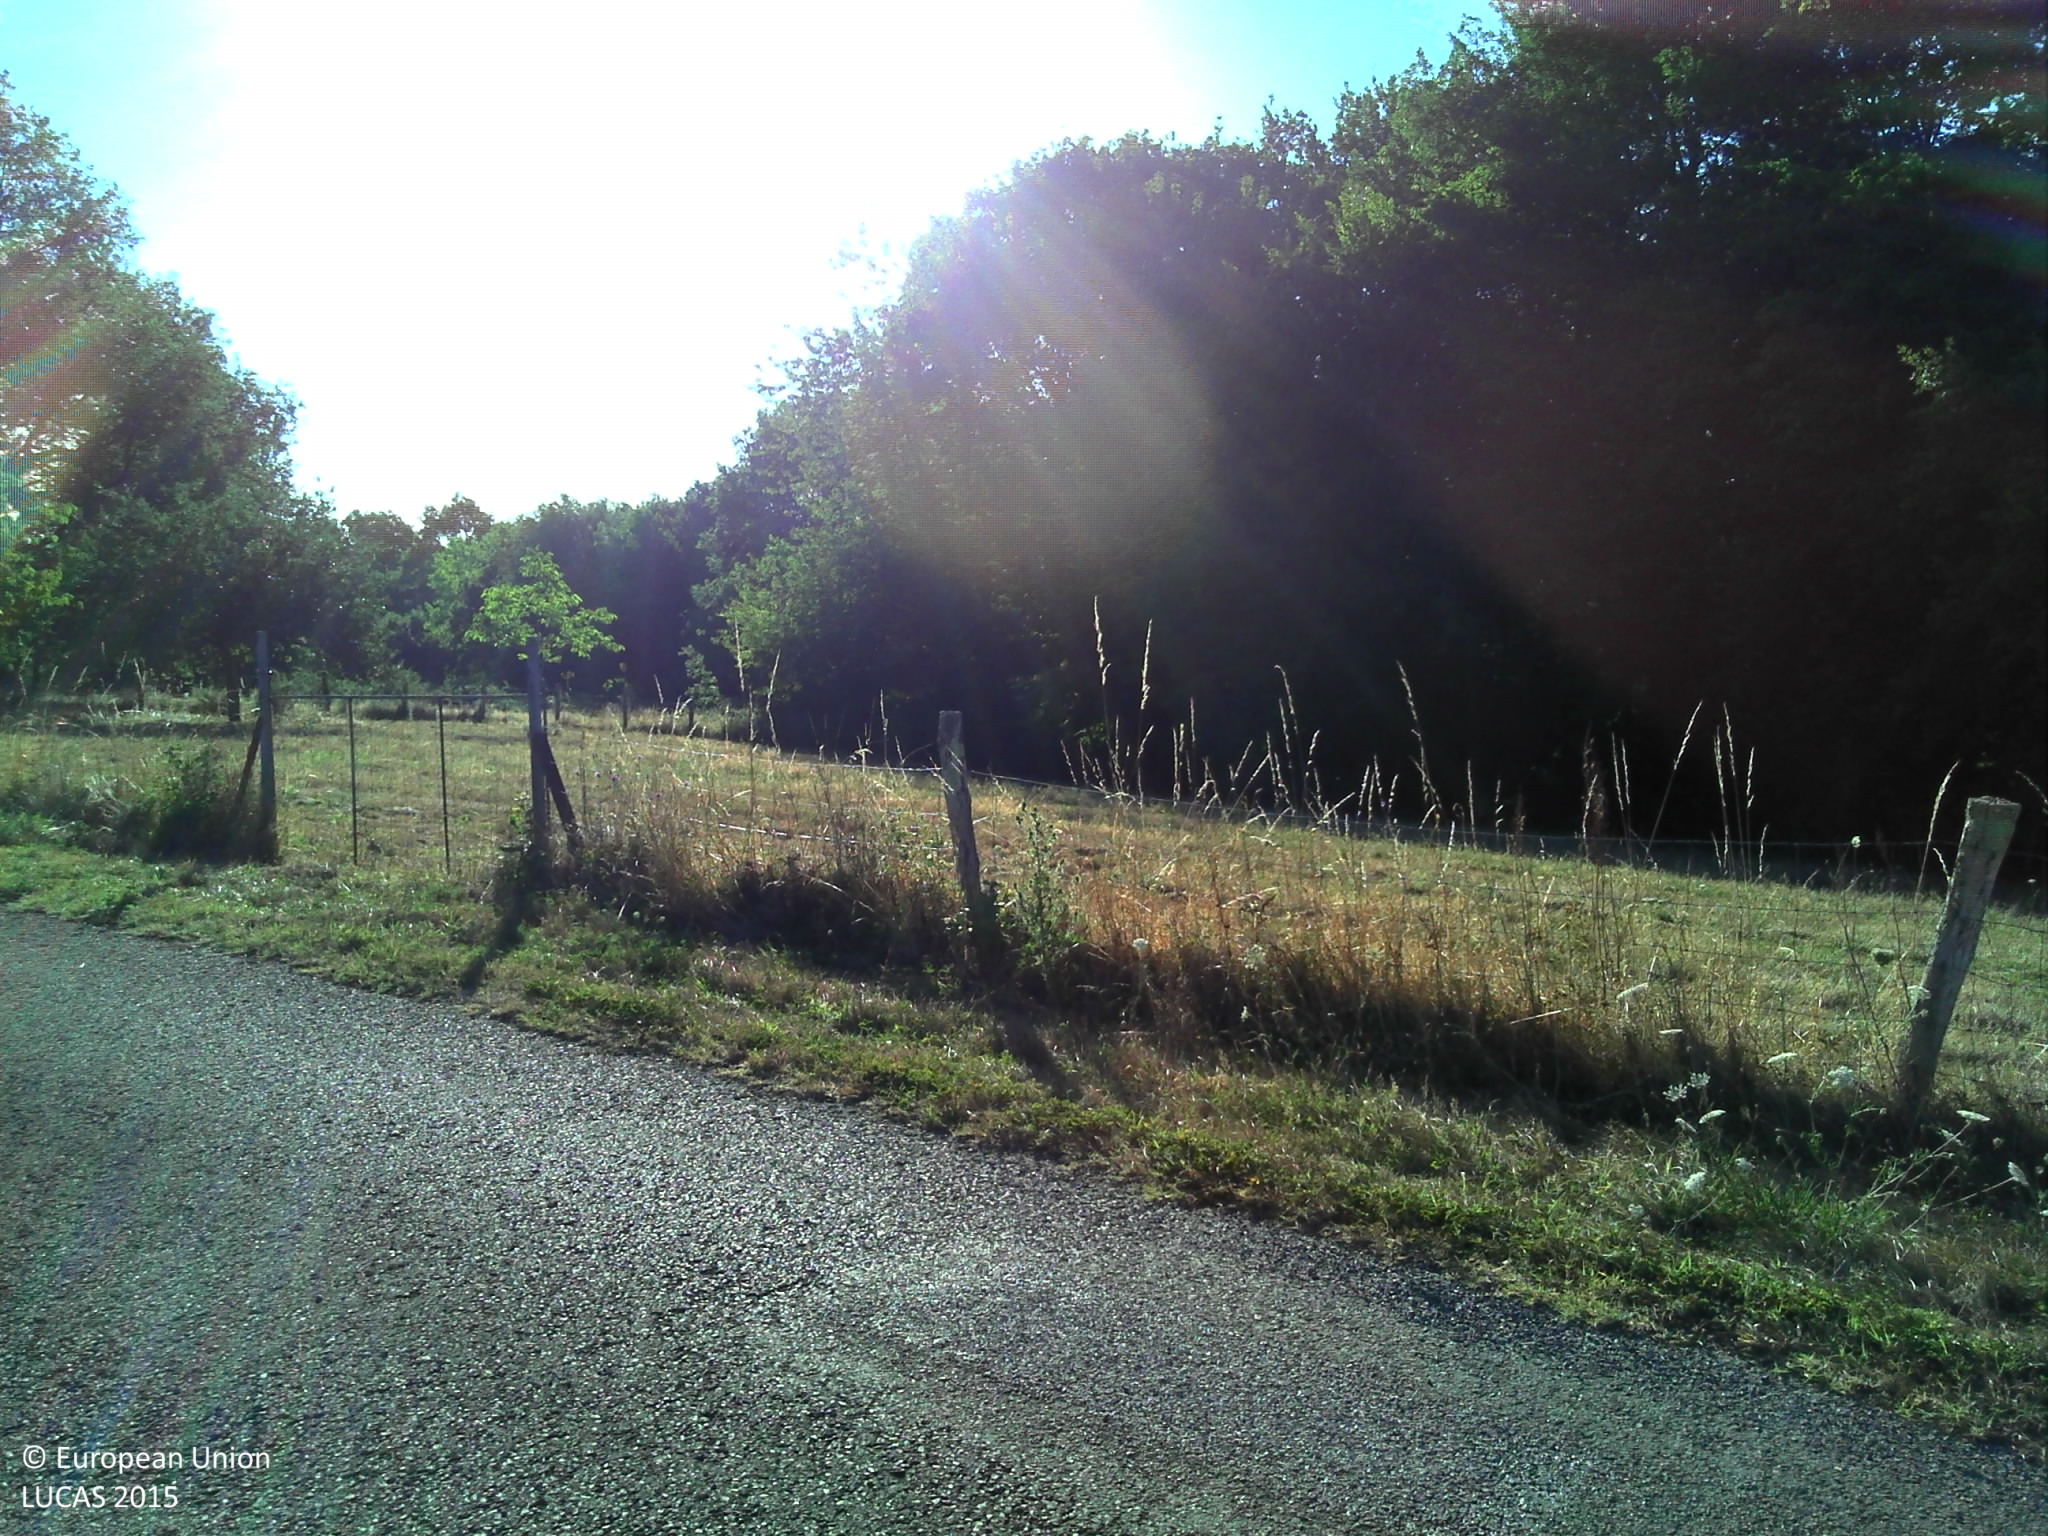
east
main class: Grassland
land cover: Grassland without tree/shrub cover
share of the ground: > 75 %
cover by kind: herbaceous plants 100 %
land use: Agriculture (excluding fallow land and kitchen gardens)
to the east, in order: Grassland without tree/shrub cover; Fences; Grass margins; Tracks; Grass margins; Fences; Grassland without tree/shrub cover; Fences; Broadleaved woodland
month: July
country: FR
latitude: 46.4036
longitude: 0.5531
